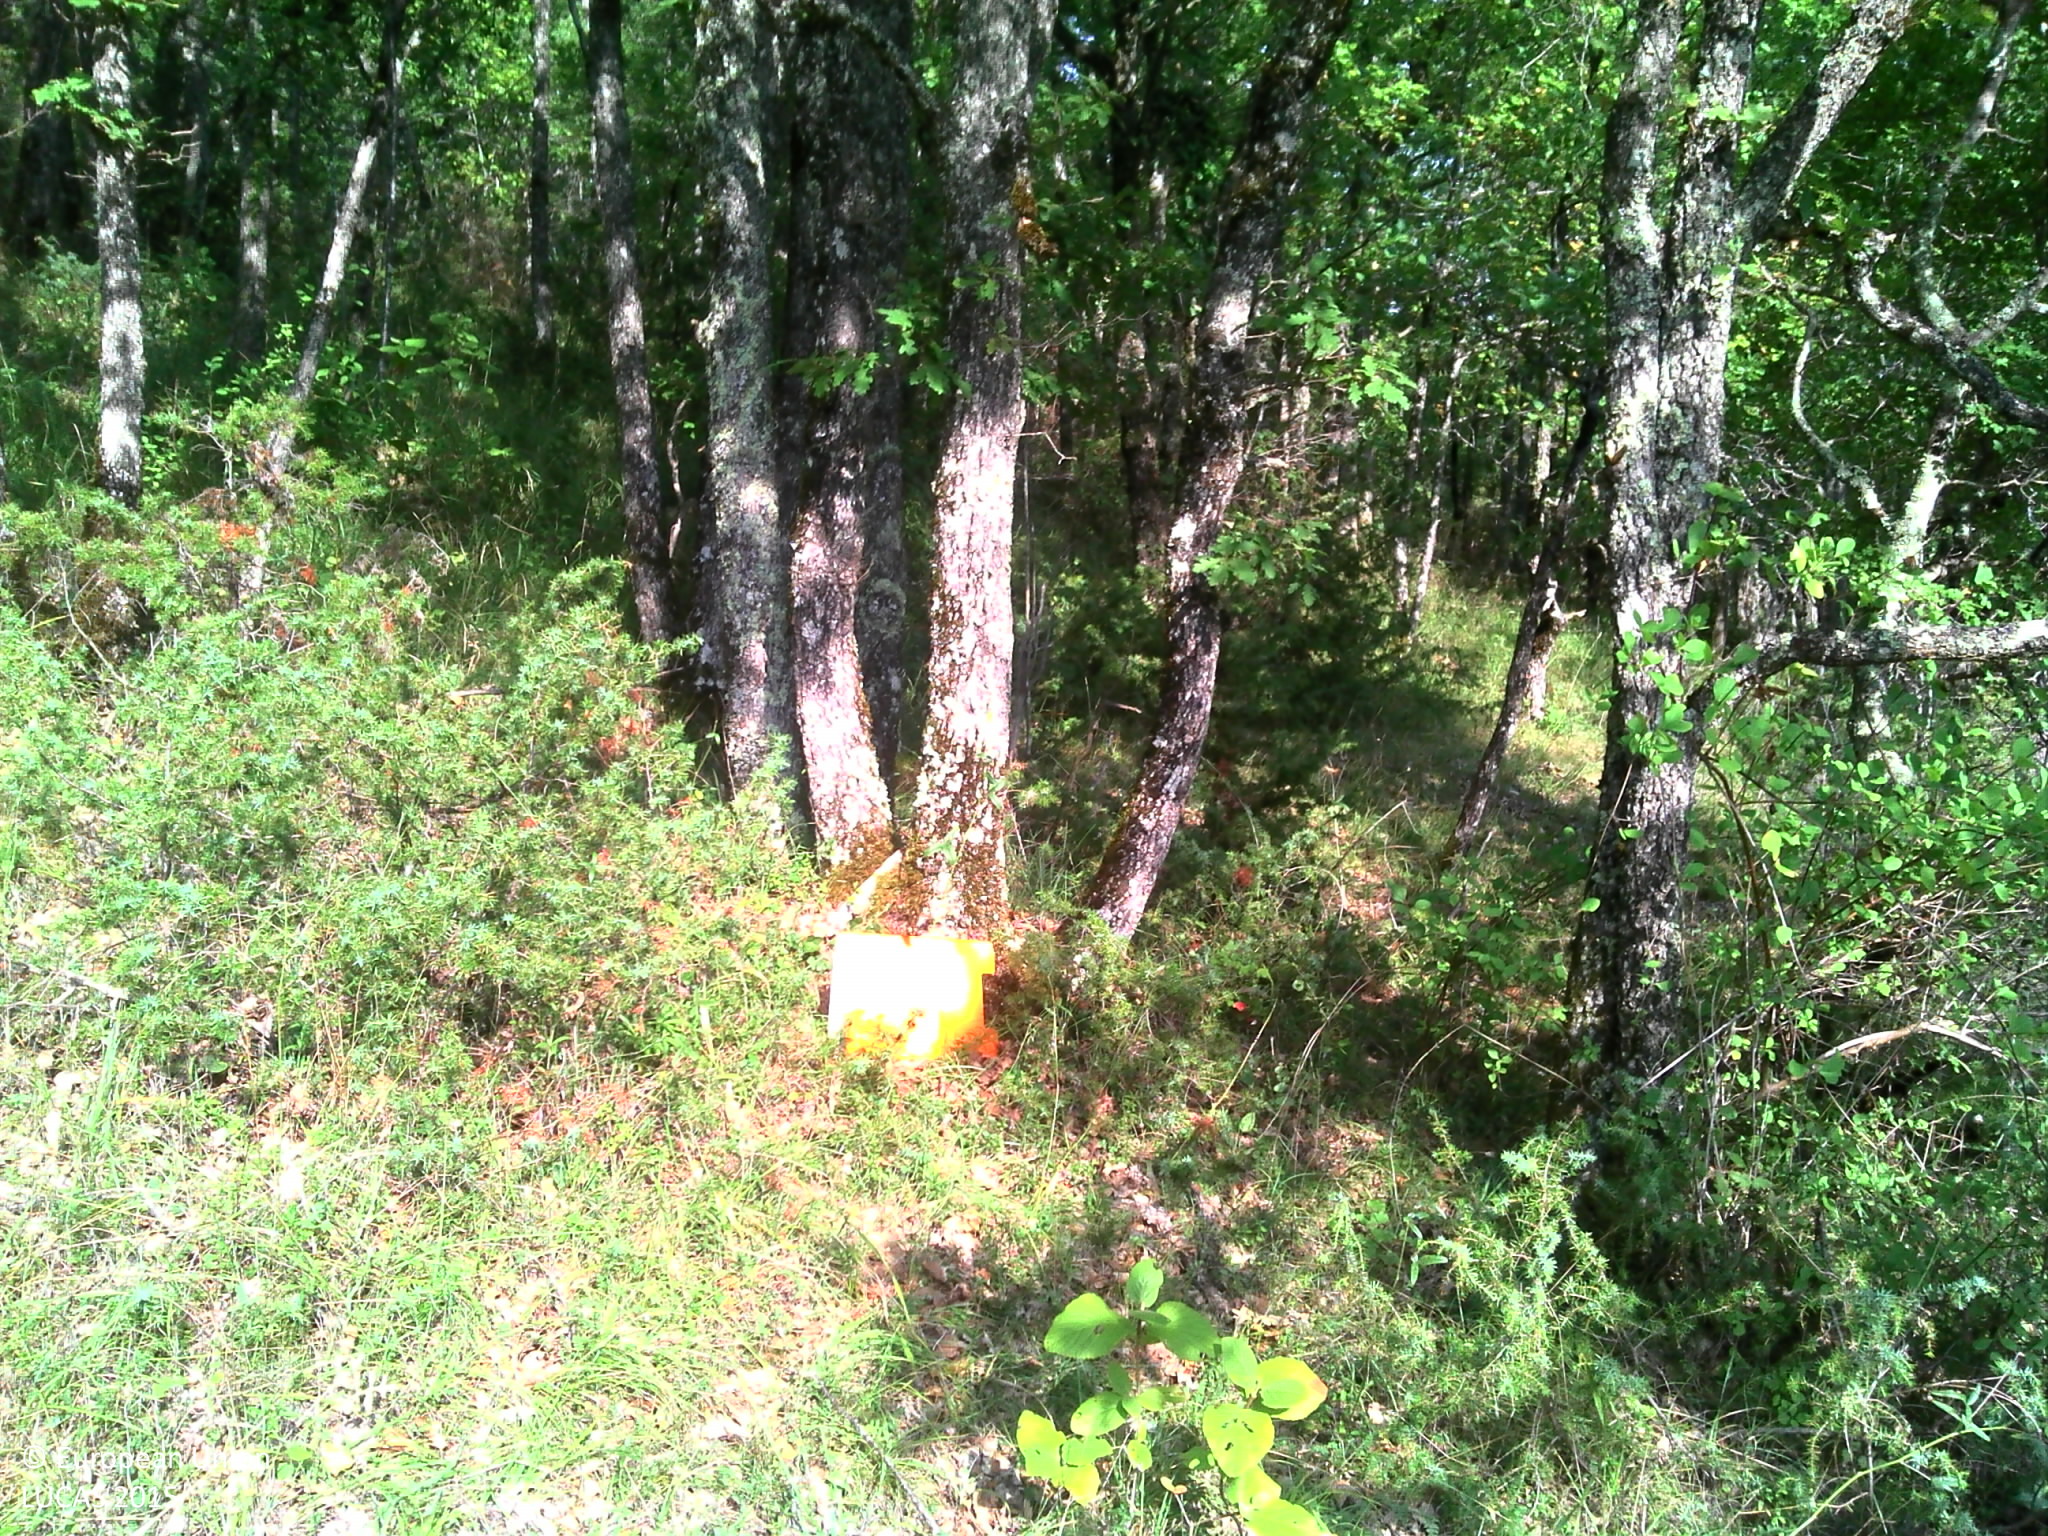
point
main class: Woodland
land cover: Broadleaved woodland
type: thermophilous deciduous forest
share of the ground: > 75 %
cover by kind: broadleaved forest trees 60 %, herbaceous plants 30 %, shrubs 10 %
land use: Forestry
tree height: > 5 m
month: September
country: FR
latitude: 44.6885
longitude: 1.4803
